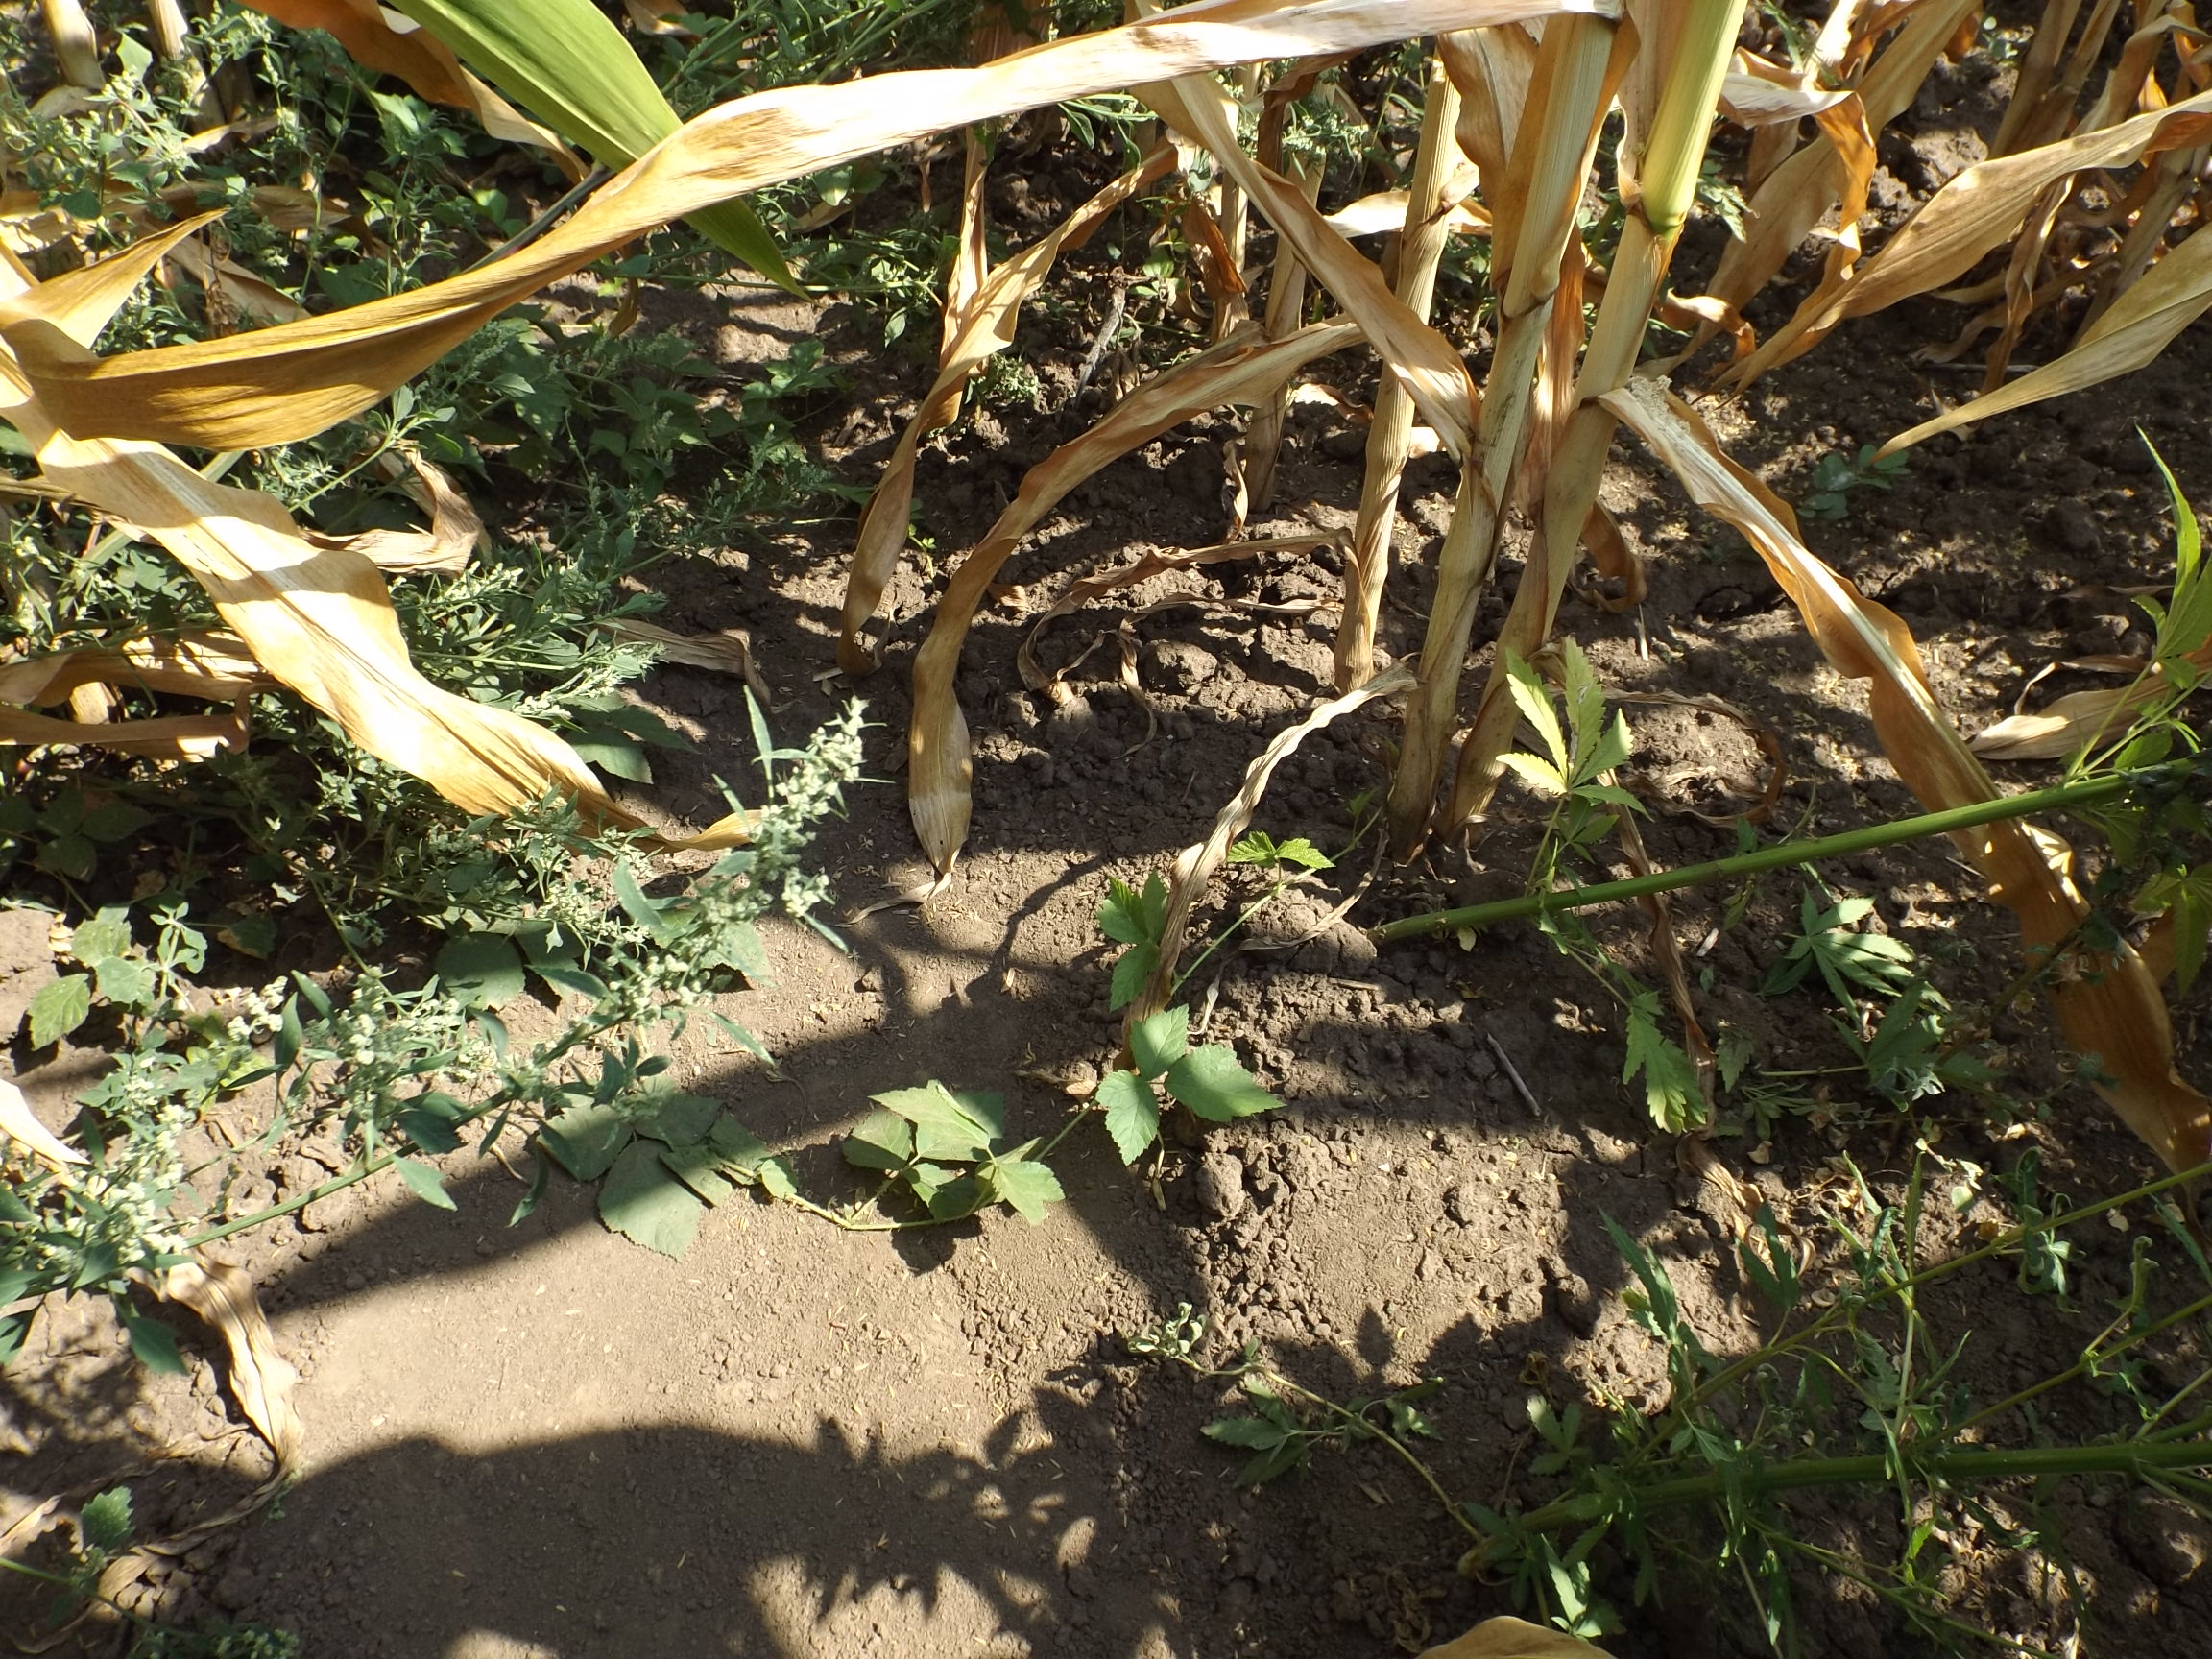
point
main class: Cropland
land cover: Maize
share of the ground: > 75 %
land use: Agriculture (excluding fallow land and kitchen gardens)
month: July
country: BG
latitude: 43.5288
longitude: 27.6183
